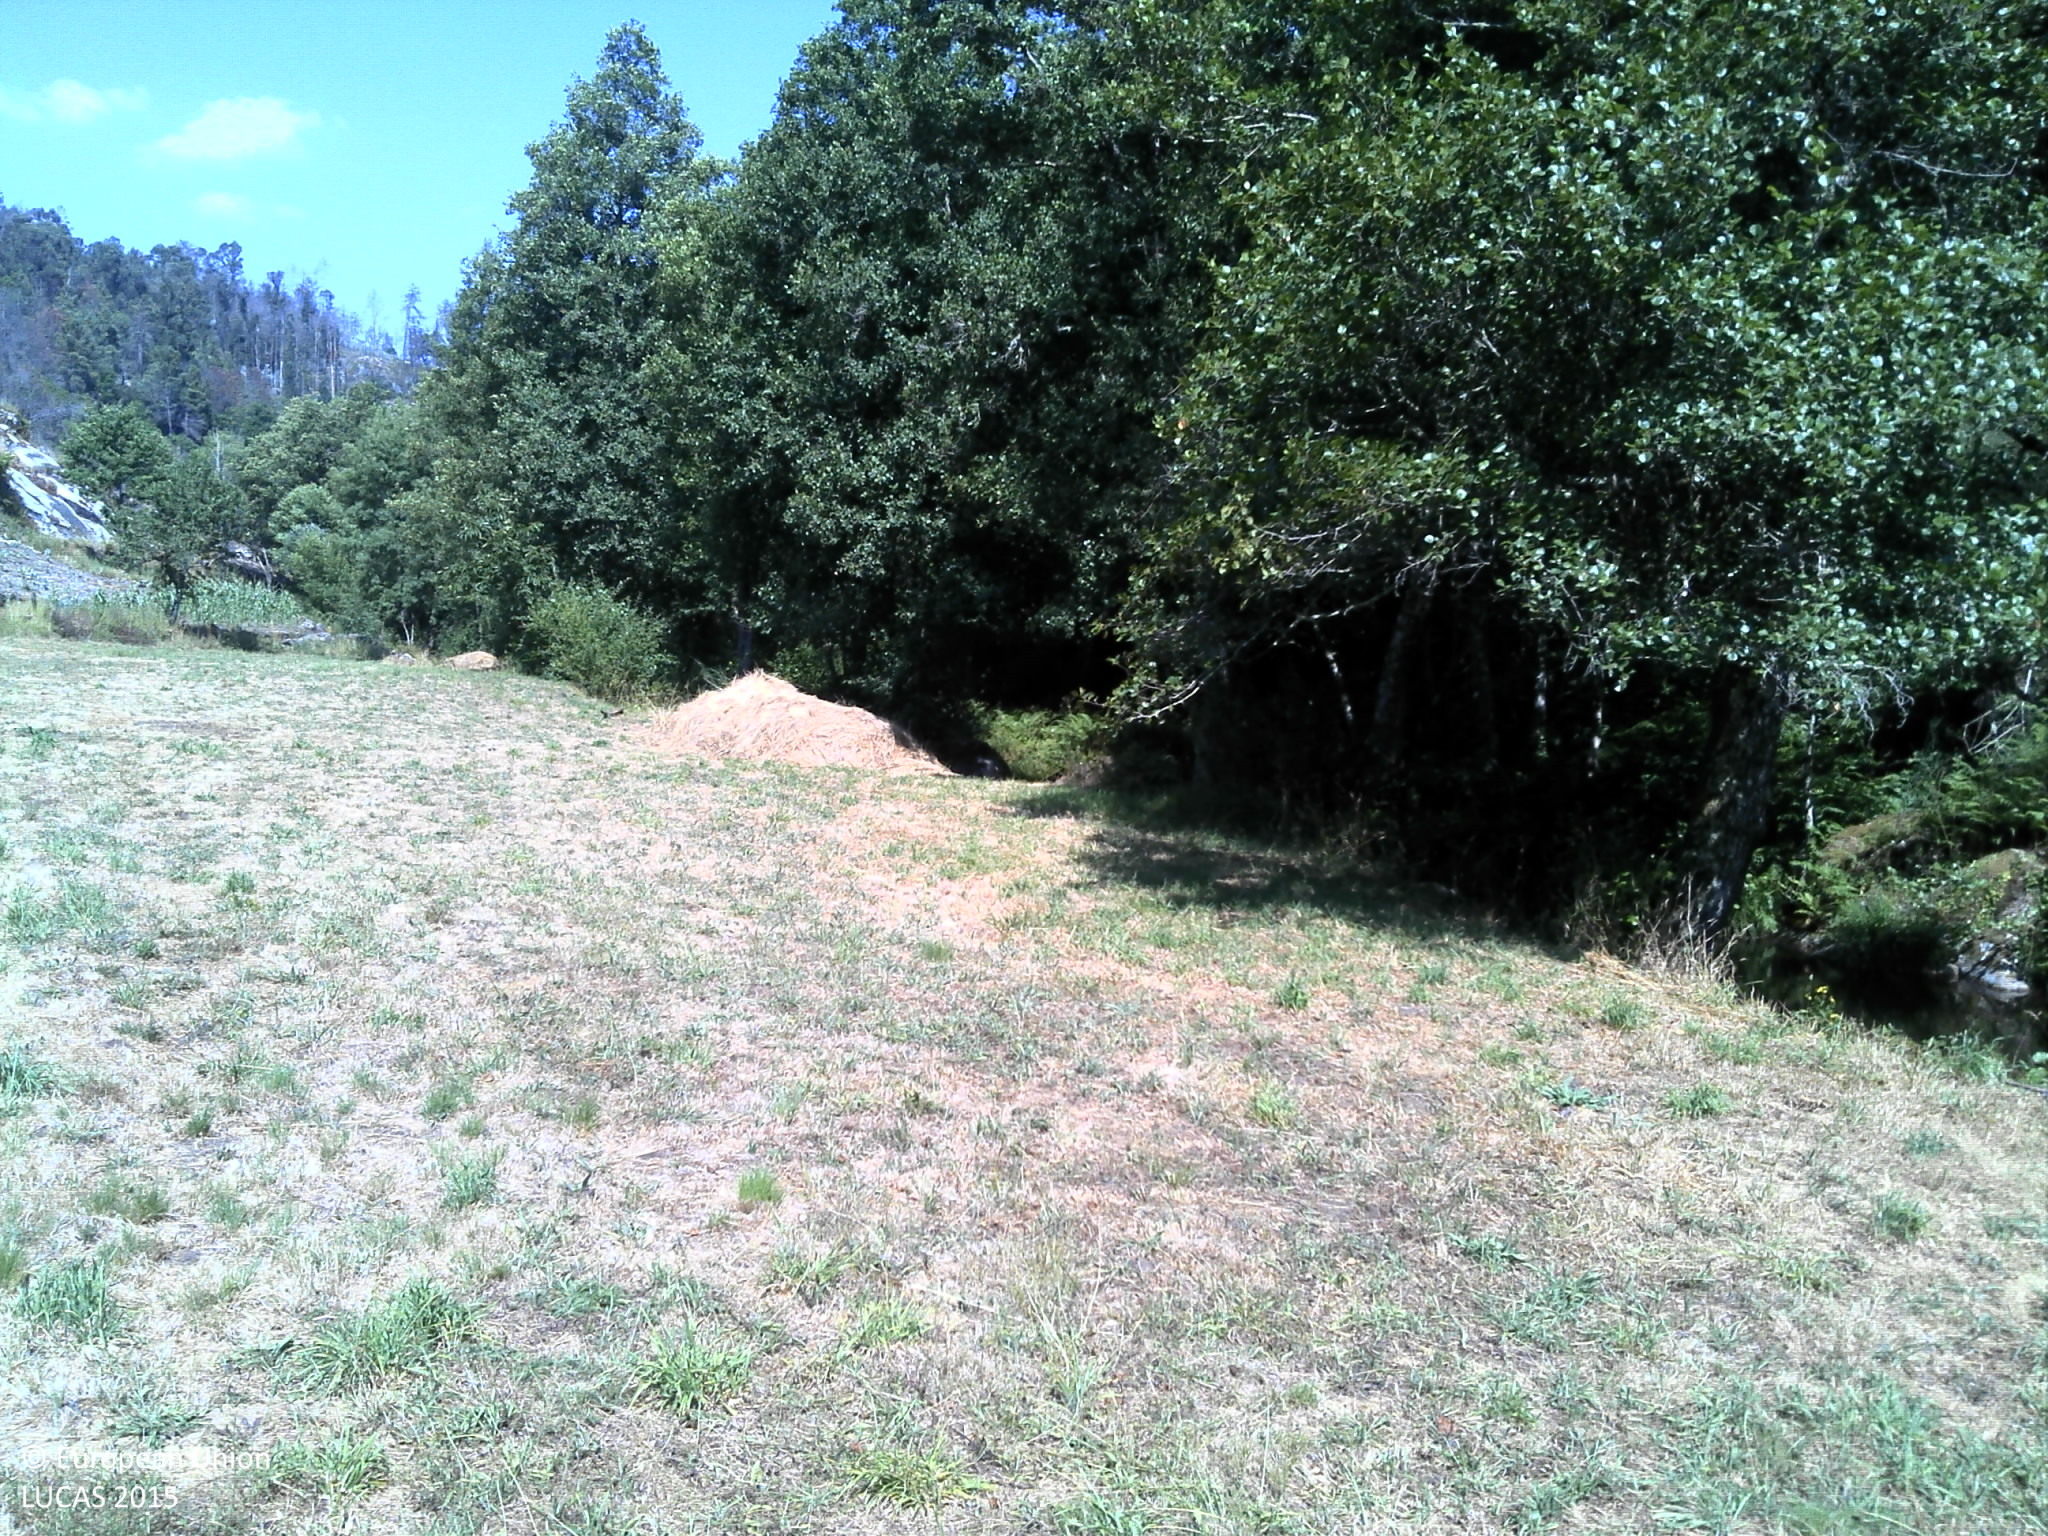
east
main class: Grassland
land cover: Grassland without tree/shrub cover
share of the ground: > 75 %
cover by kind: herbaceous plants 100 %
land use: Agriculture (excluding fallow land and kitchen gardens)
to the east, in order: Grassland without tree/shrub cover; Abandoned hedges; Rivers and streams; Broadleaved woodland; Shrubland without tree cover; Broadleaved woodland; Shrubland without tree cover; Broadleaved woodland
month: July
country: PT
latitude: 40.9053
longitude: -7.8511
